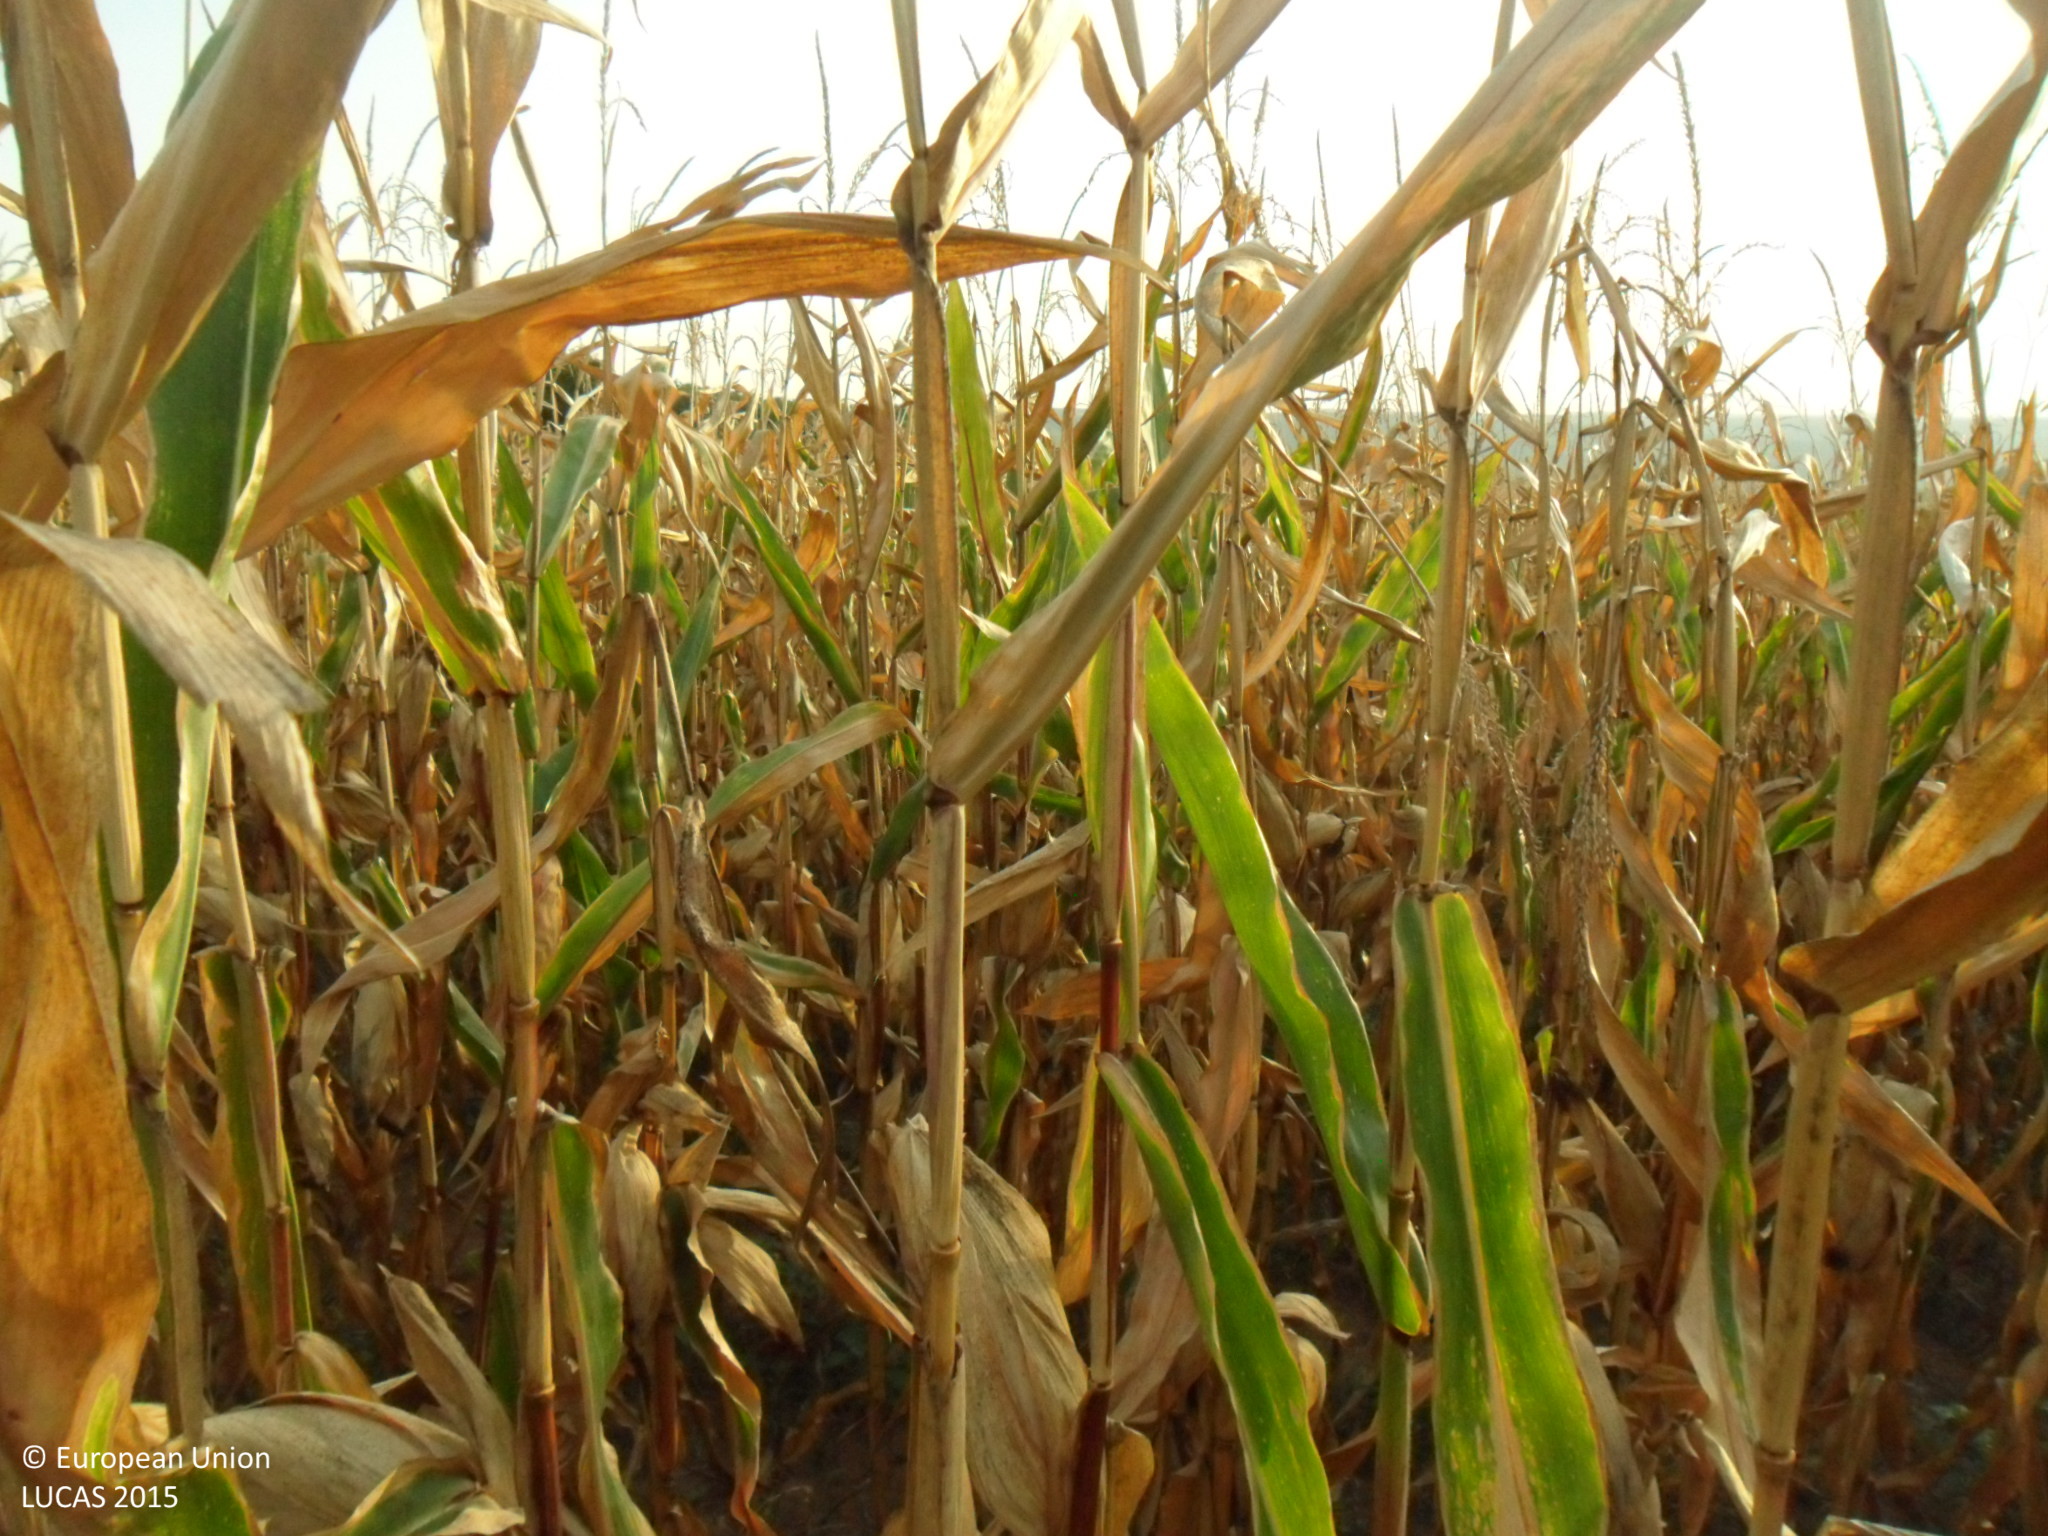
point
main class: Cropland
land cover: Maize
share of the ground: > 75 %
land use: Agriculture (excluding fallow land and kitchen gardens)
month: September
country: BG
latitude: 43.5840
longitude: 26.1856
